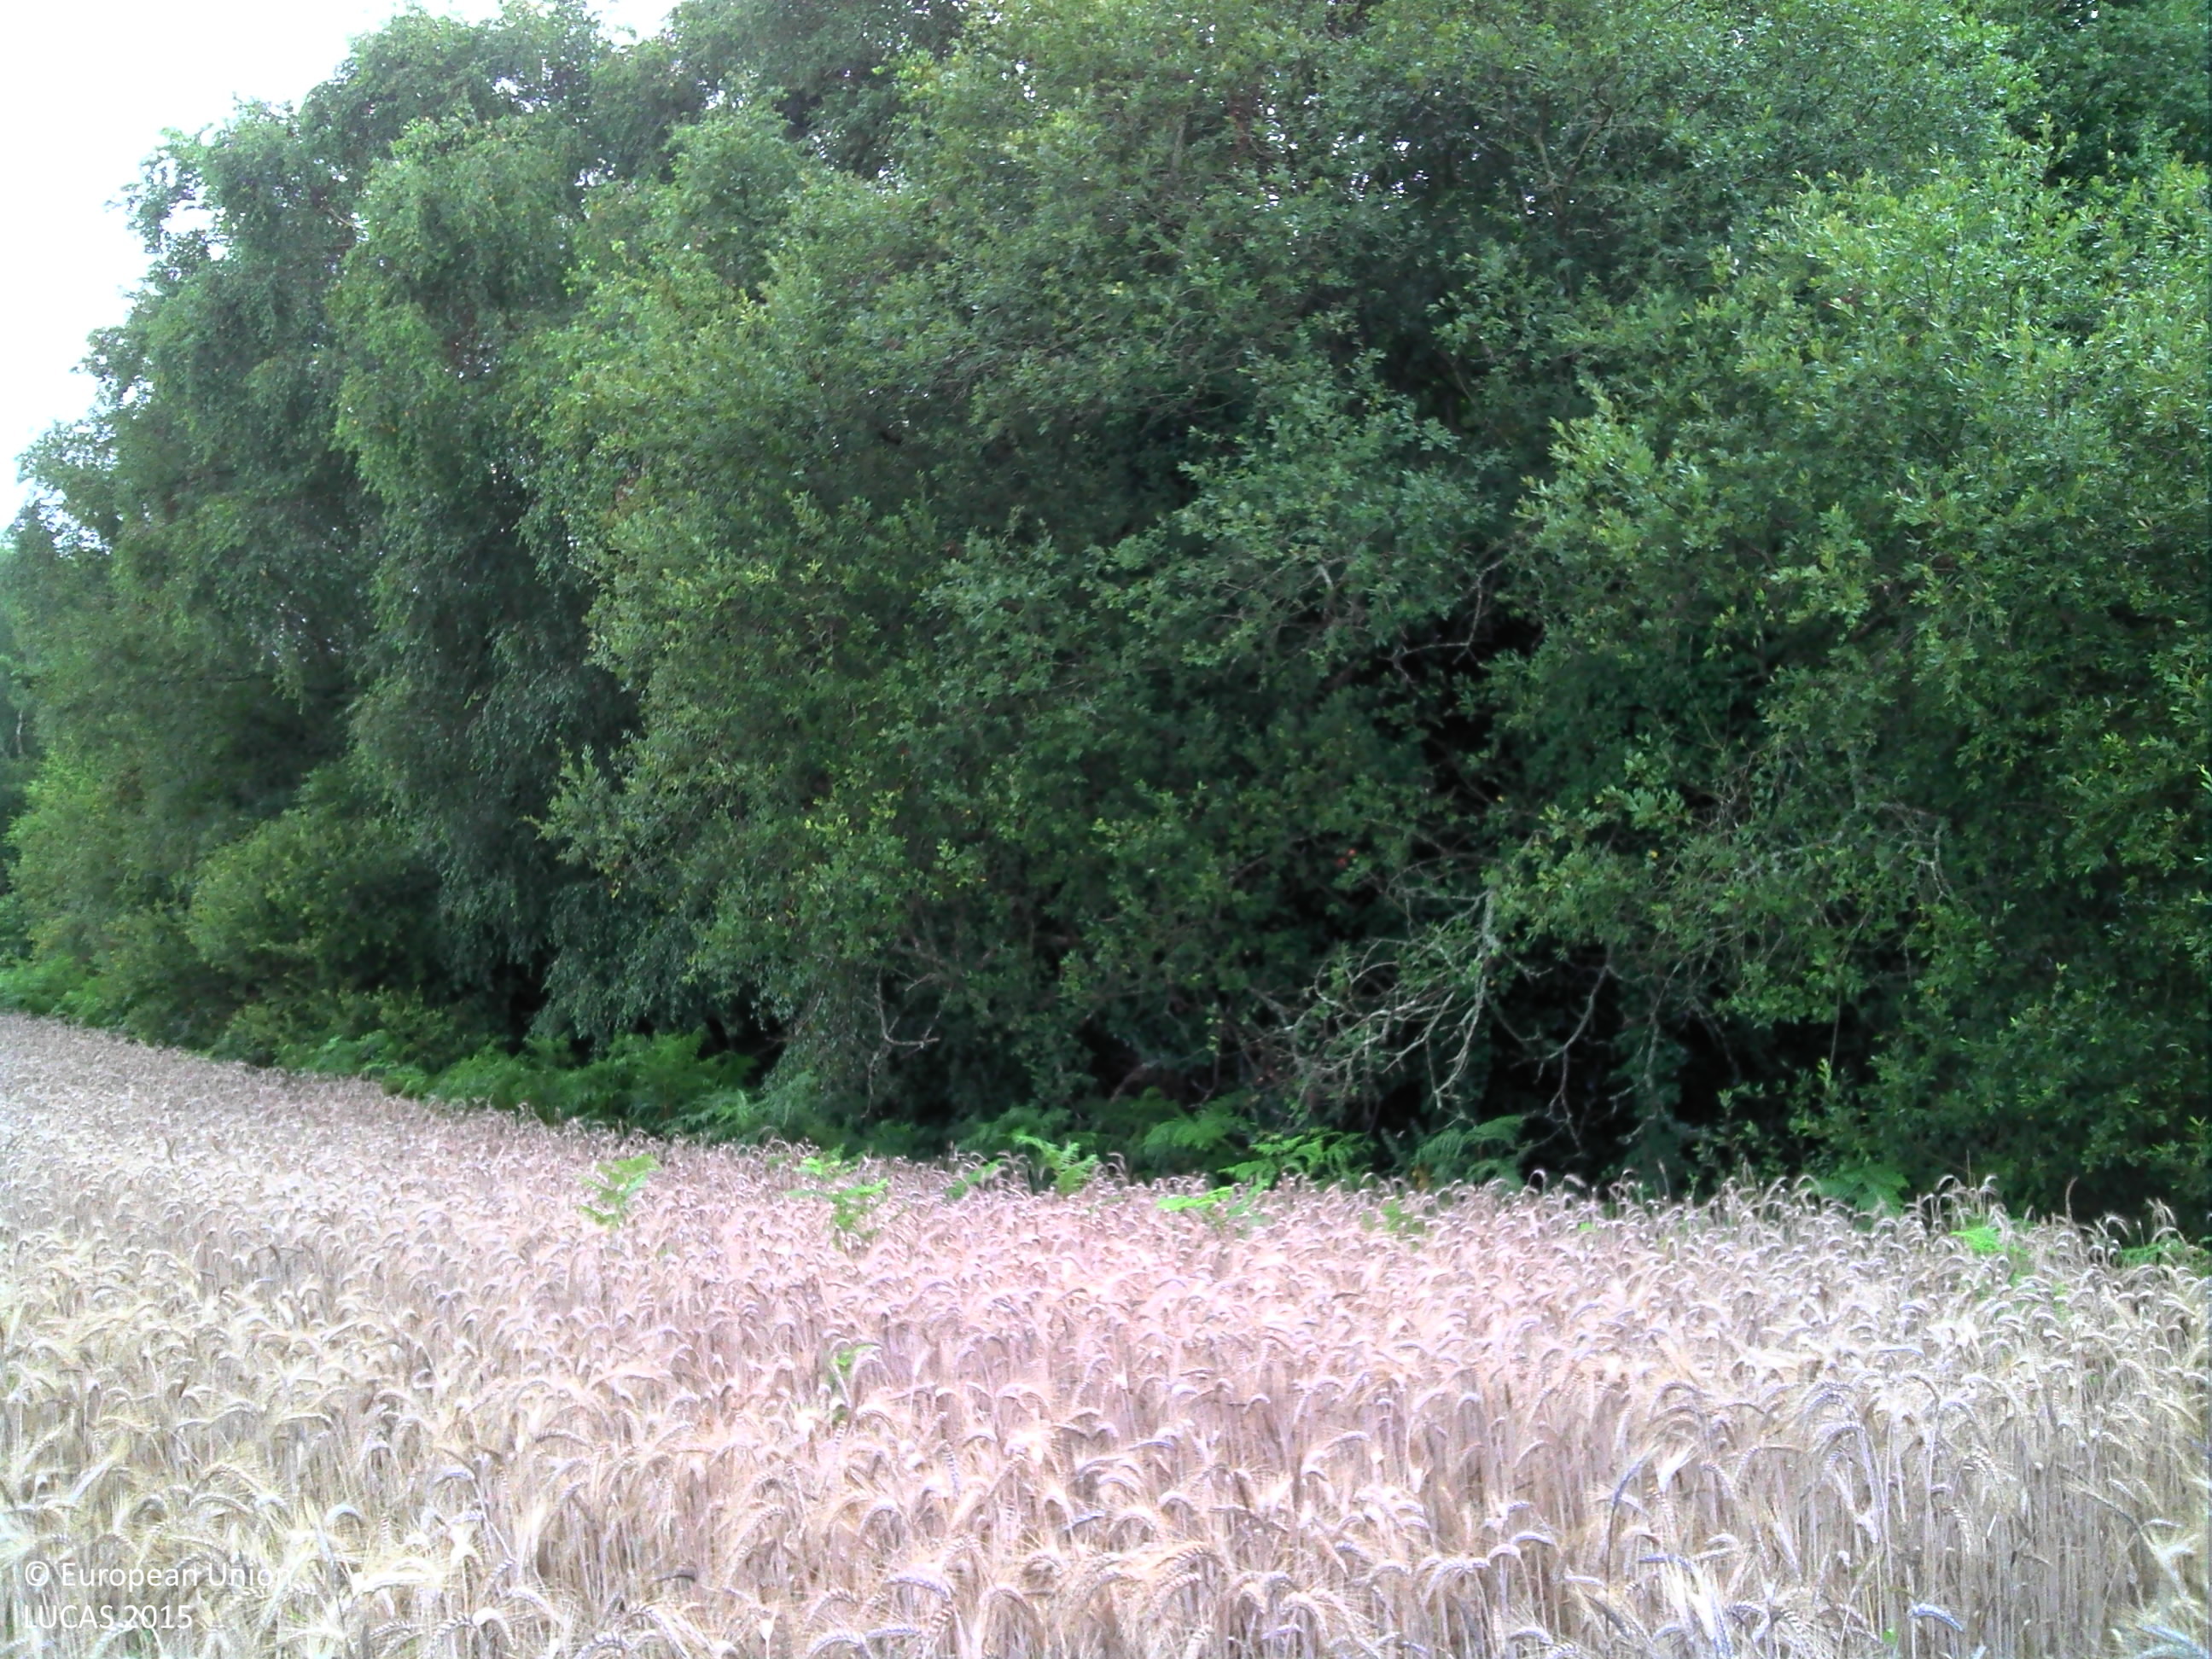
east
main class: Cropland
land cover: Common wheat
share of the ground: > 75 %
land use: Agriculture (excluding fallow land and kitchen gardens)
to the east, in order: Common wheat; Other mixed woodland; Inland marshes; Other mixed woodland; Rivers and streams; Other mixed woodland; Fences; Other mixed woodland
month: July
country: FR
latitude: 47.9883
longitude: -3.5166
